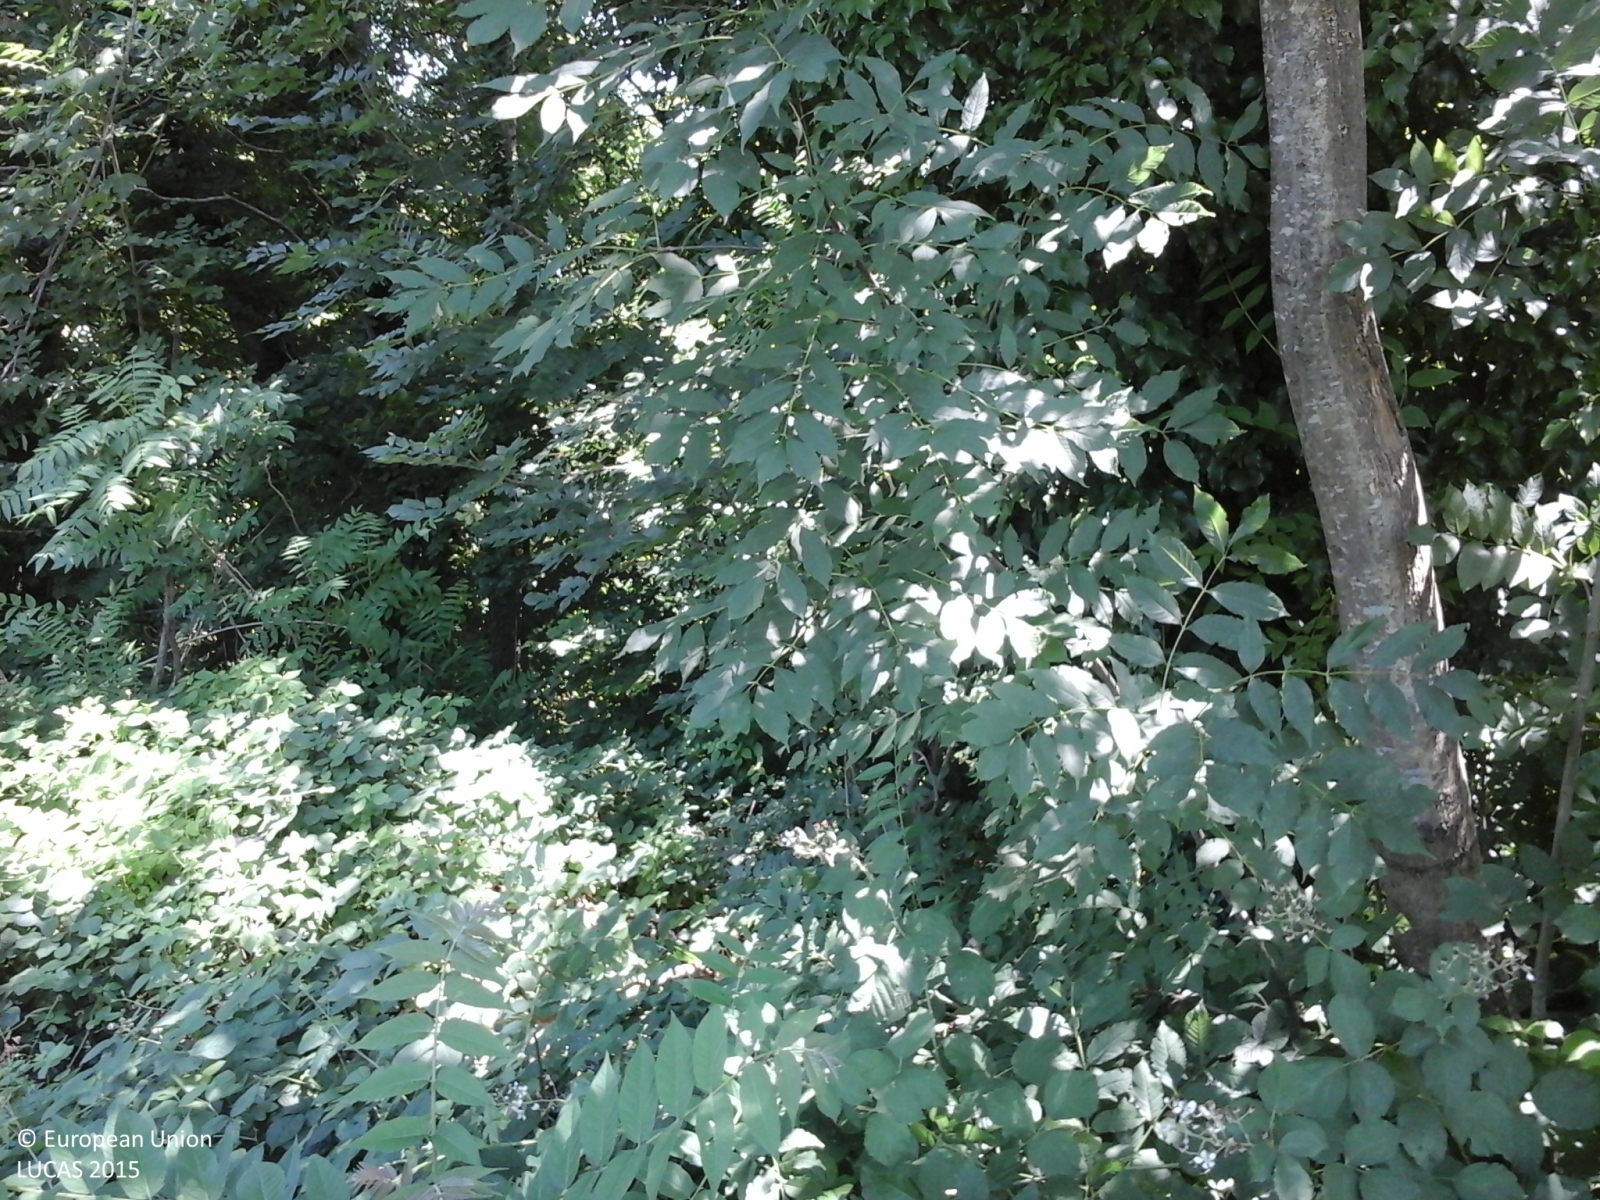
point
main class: Woodland
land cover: Broadleaved woodland
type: thermophilous deciduous forest
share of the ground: > 75 %
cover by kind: broadleaved forest trees 80 %, shrubs 15 %, herbaceous plants 5 %
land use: Semi-natural and natural areas not in use
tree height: > 5 m
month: June
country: IT
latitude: 44.3794
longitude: 7.7080
